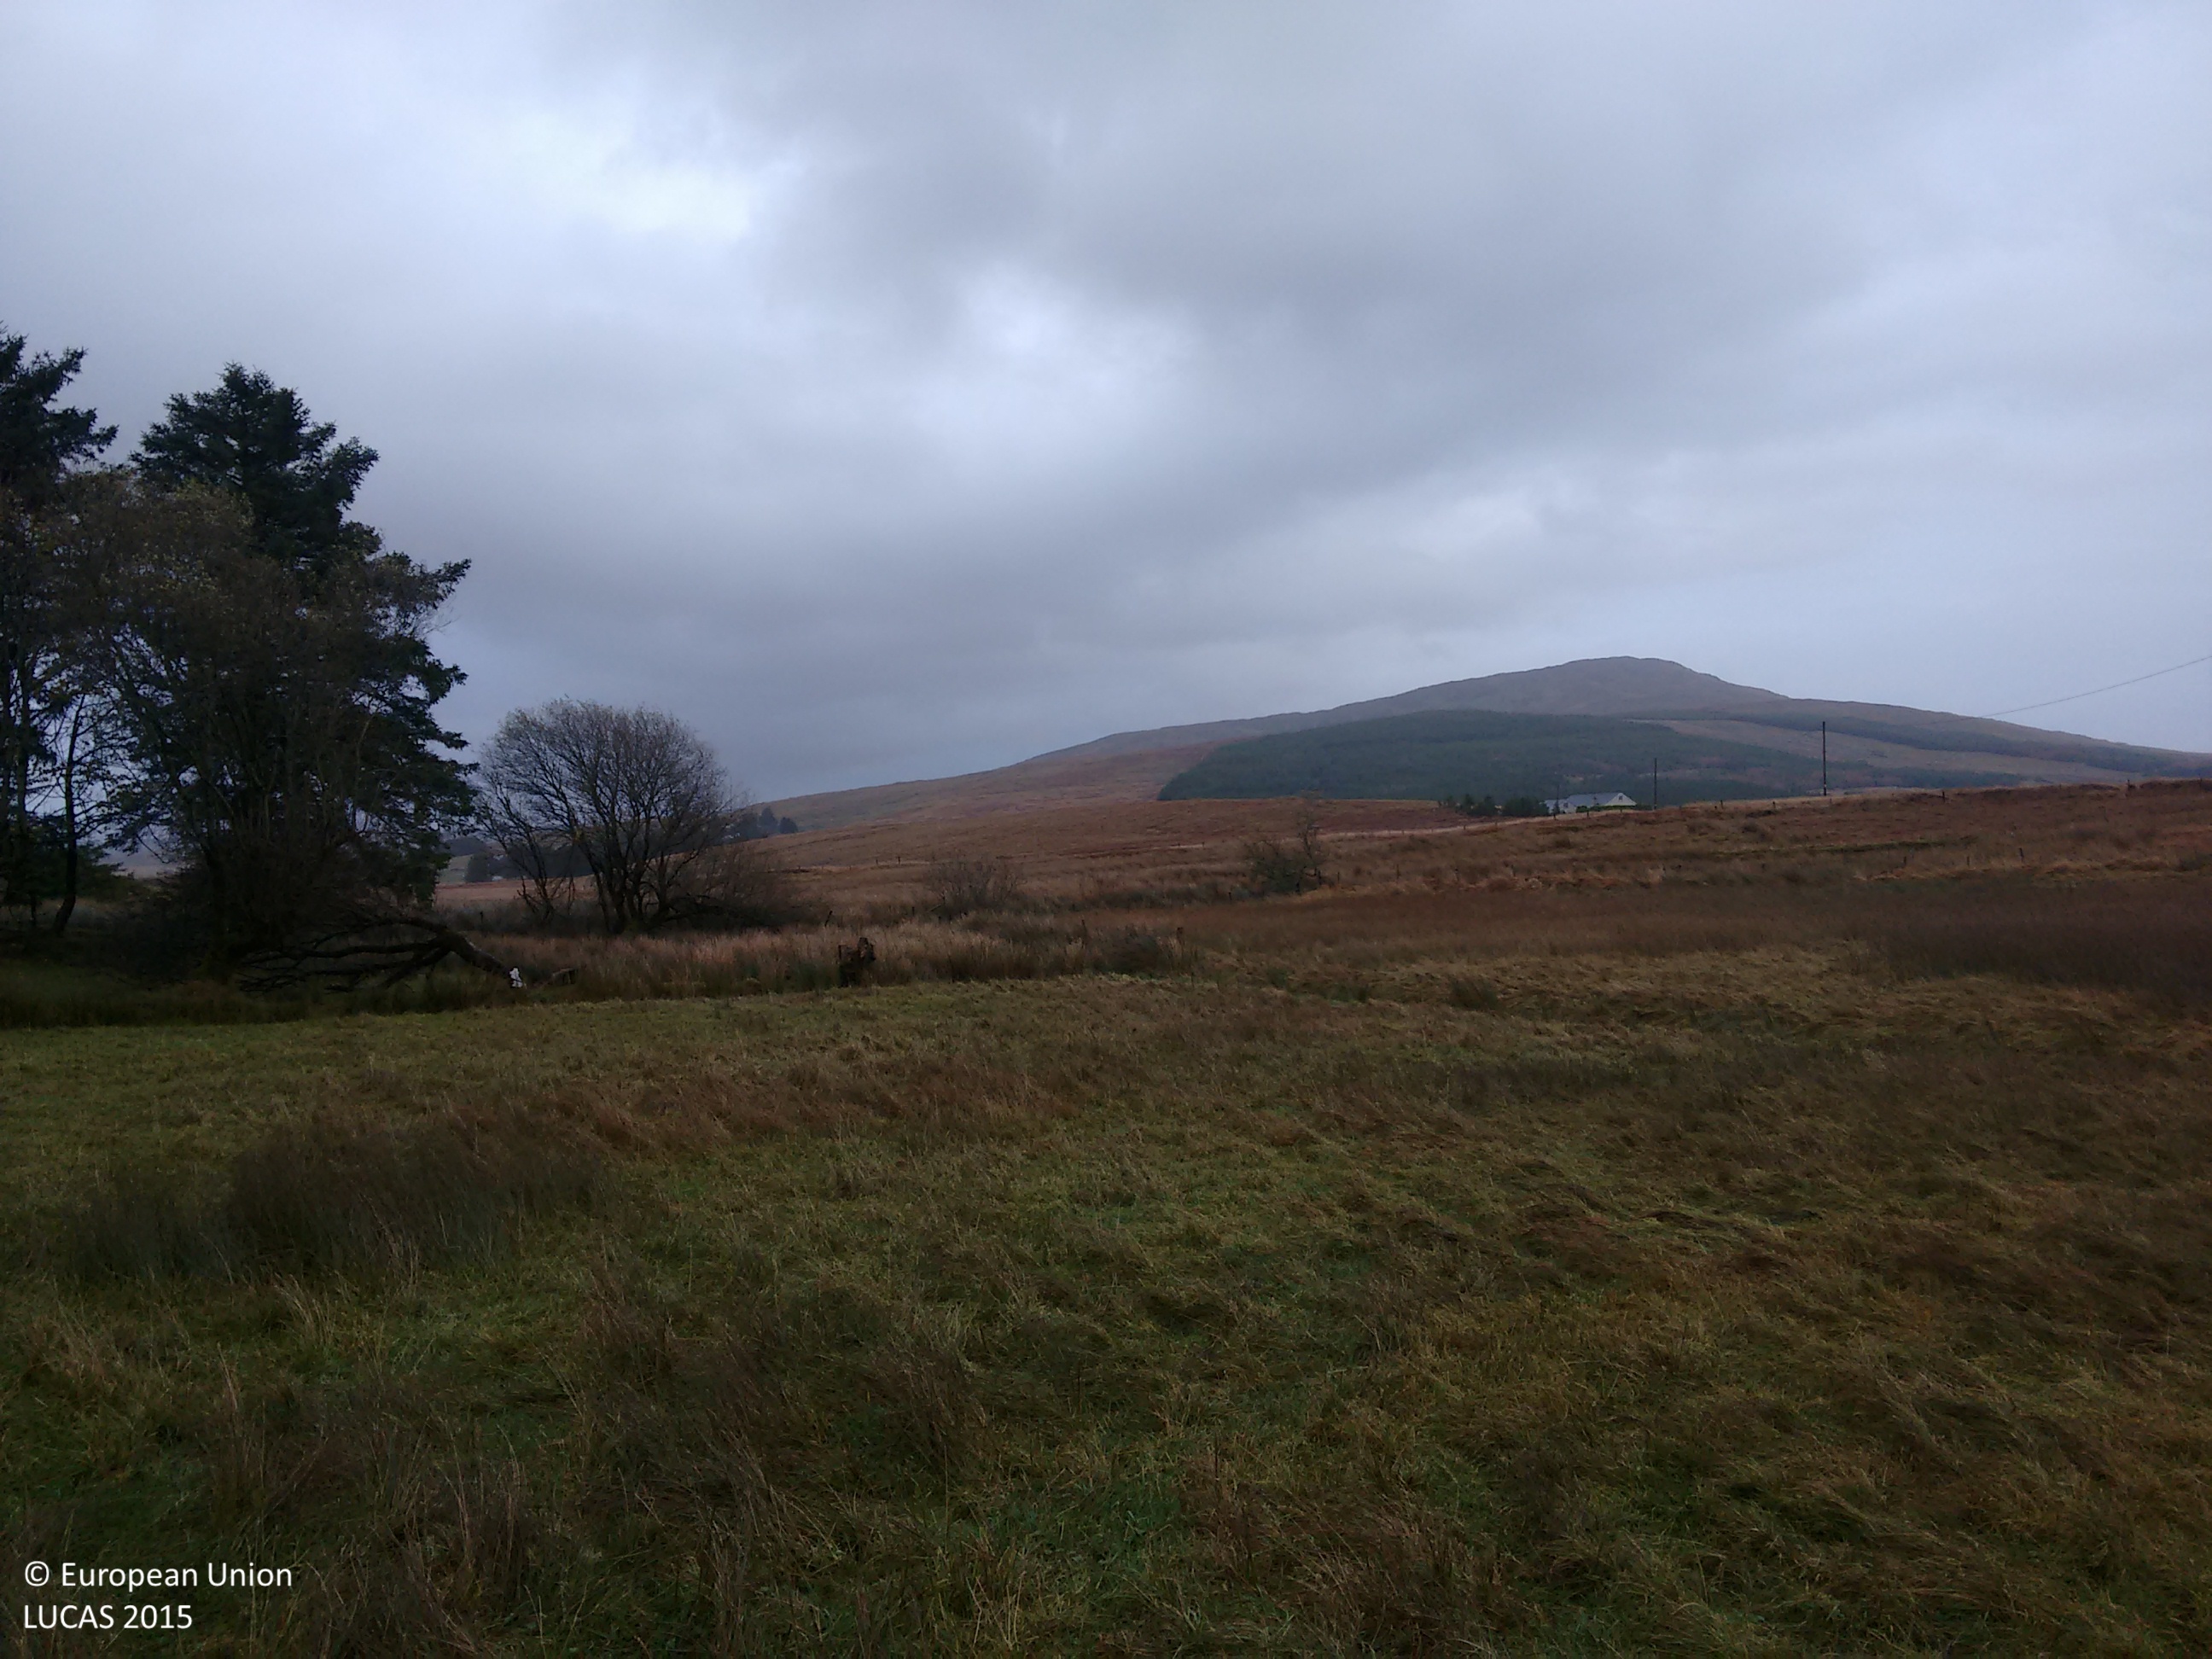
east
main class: Grassland
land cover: Grassland without tree/shrub cover
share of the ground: > 75 %
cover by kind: herbaceous plants 100 %
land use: Agriculture (excluding fallow land and kitchen gardens)
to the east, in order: Grassland without tree/shrub cover; Ditches and canals; Grassland without tree/shrub cover; Fences; Shruby margins; Grassland without tree/shrub cover; Electric lines; Grassland without tree/shrub cover; Fences; Grassland without tree/shrub cover
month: November
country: IE
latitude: 54.7238
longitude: -8.3025
